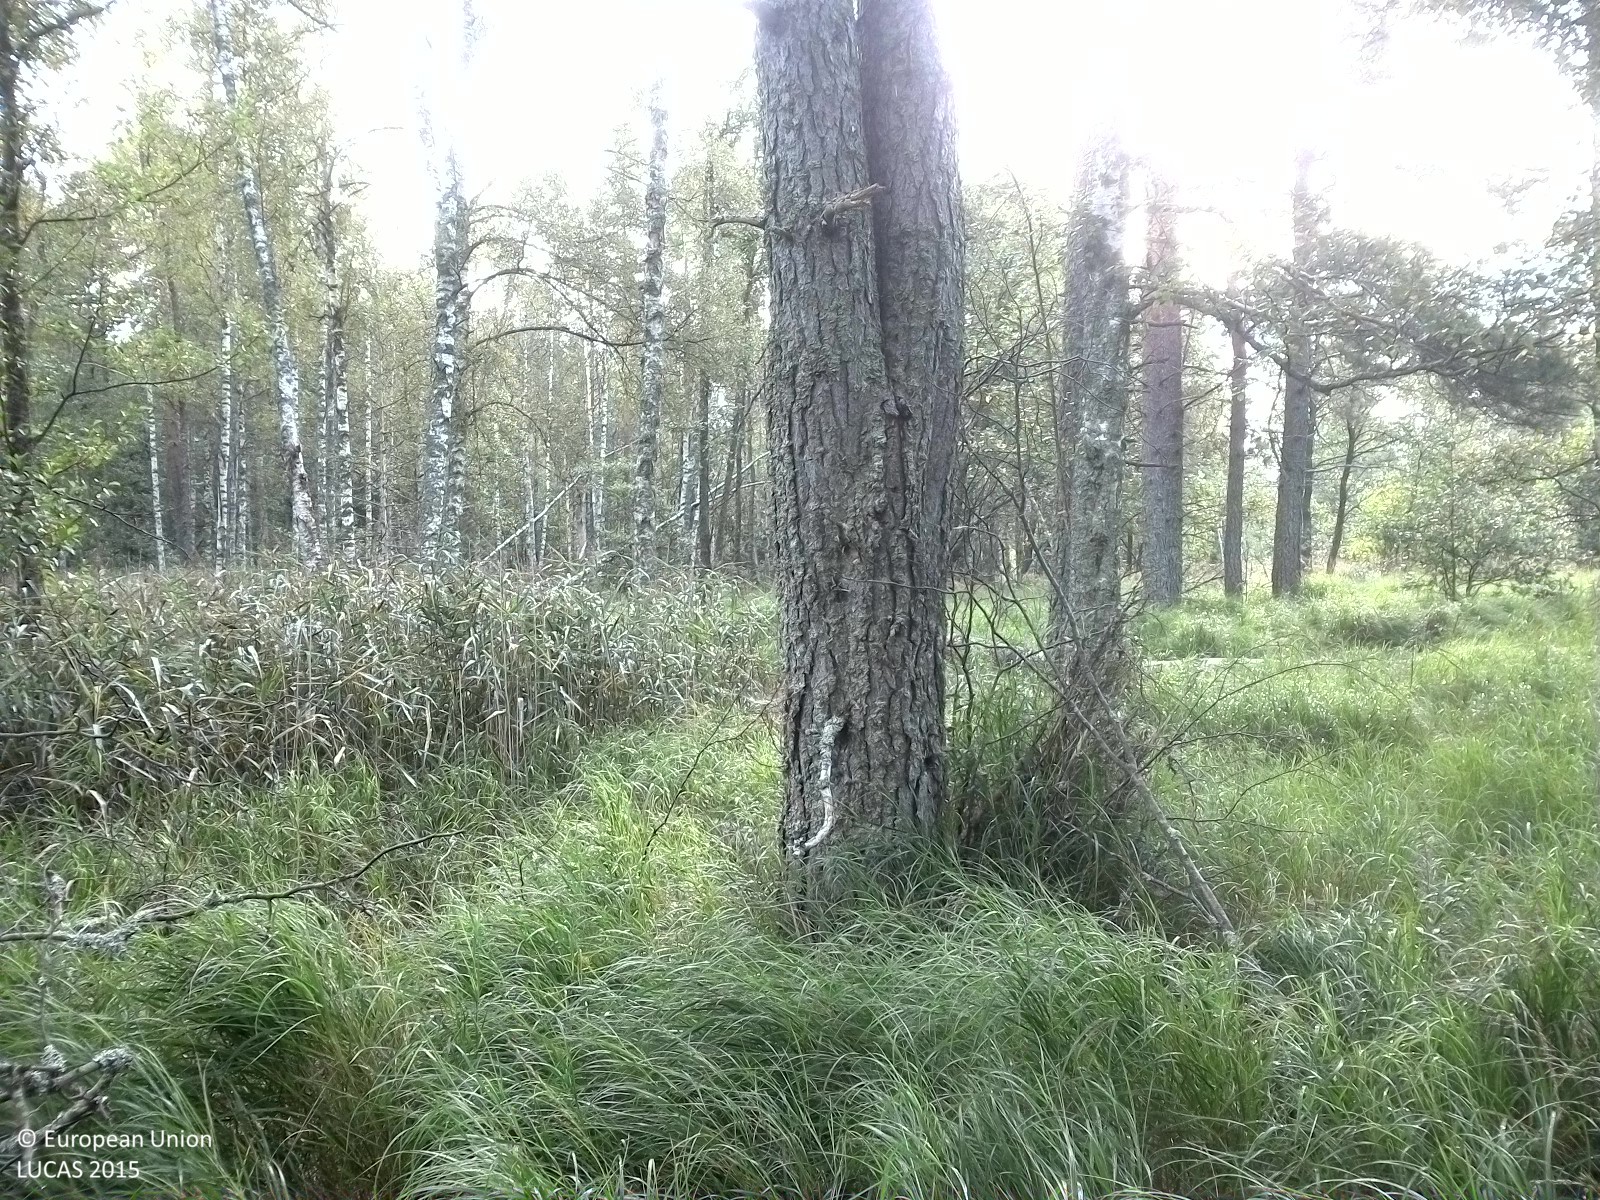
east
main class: Woodland
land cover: Pine dominated mixed woodland
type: boreal forest
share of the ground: 10 - 25 %
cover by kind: herbaceous plants 80 %, coniferous forest trees 15 %, broadleaved forest trees 5 %
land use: Semi-natural and natural areas not in use
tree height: > 5 m
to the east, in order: Pine dominated mixed woodland; Broadleaved woodland; Shrubland with sparse tree cover; Spruce dominated mixed woodland; Grass margins; Paved roads, cycling and walking lanes; Spruce dominated mixed woodland; Broadleaved woodland
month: August
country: SE
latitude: 58.8484
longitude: 15.4524
